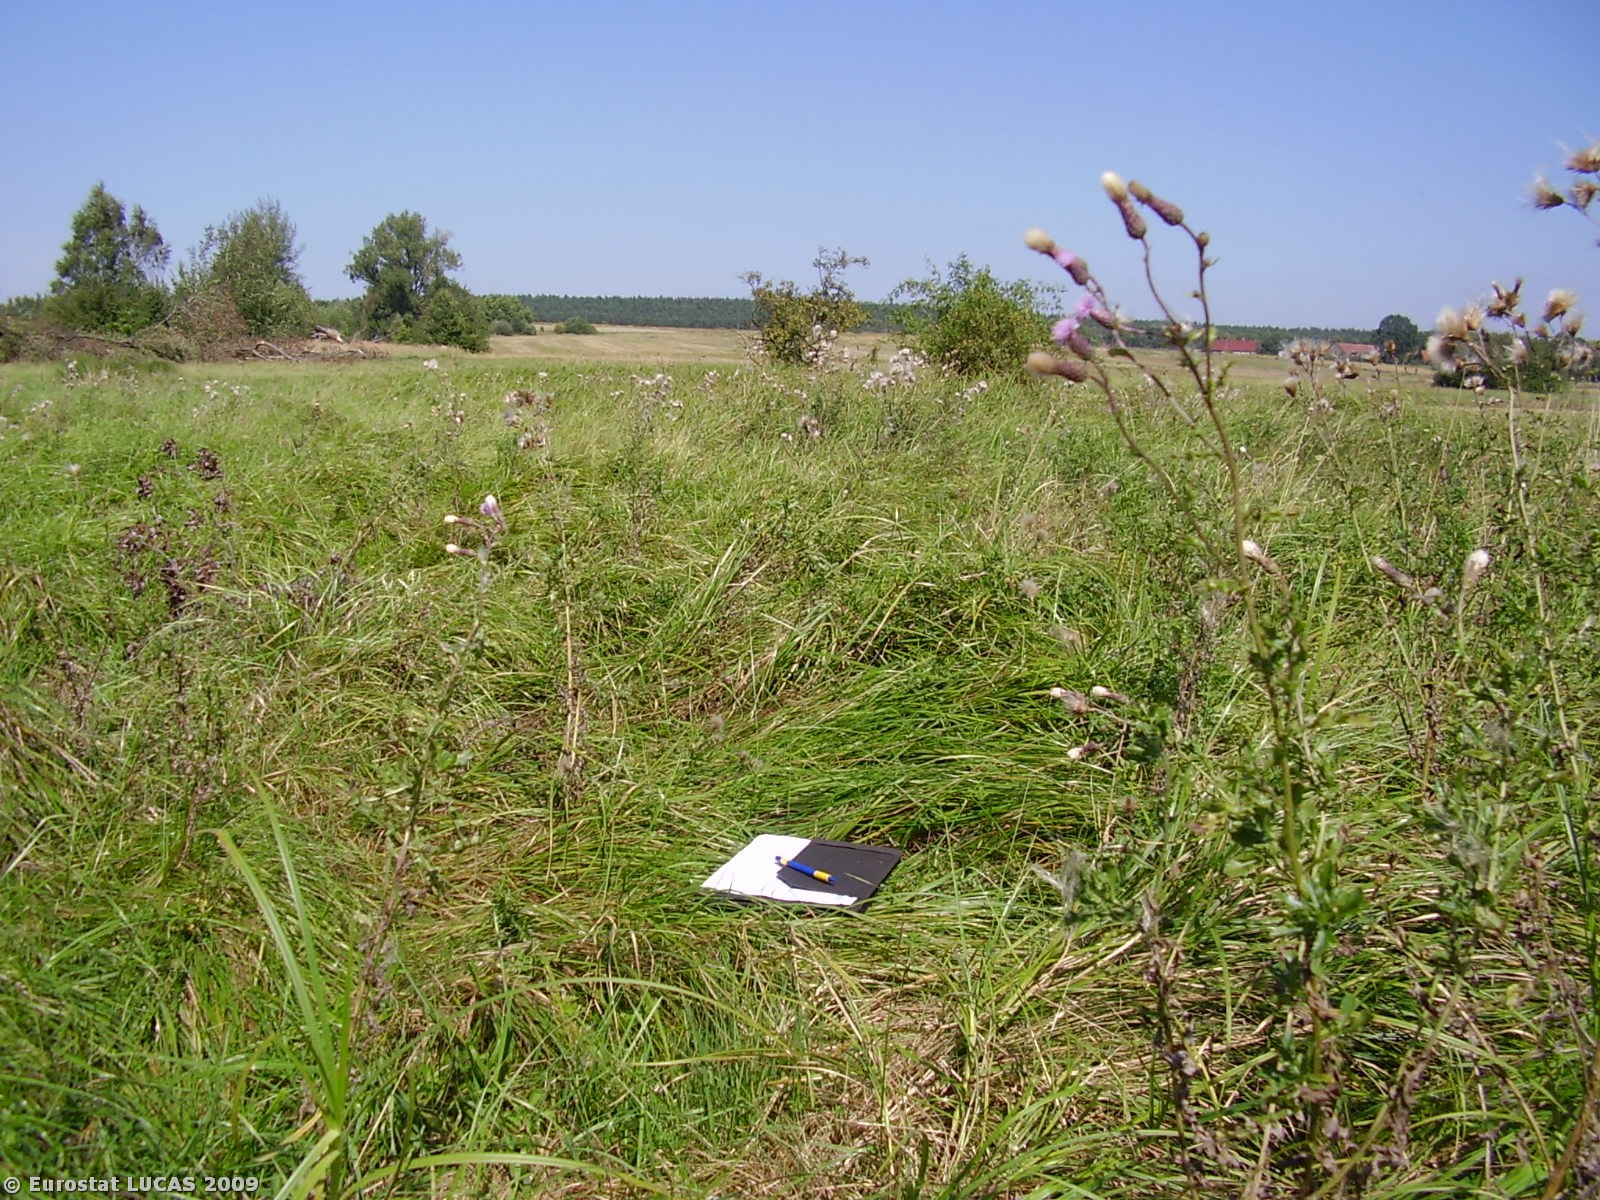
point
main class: Grassland
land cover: Grassland without tree/shrub cover
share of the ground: > 75 %
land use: Unused
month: August
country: PL
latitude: 51.2817
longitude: 16.1282
